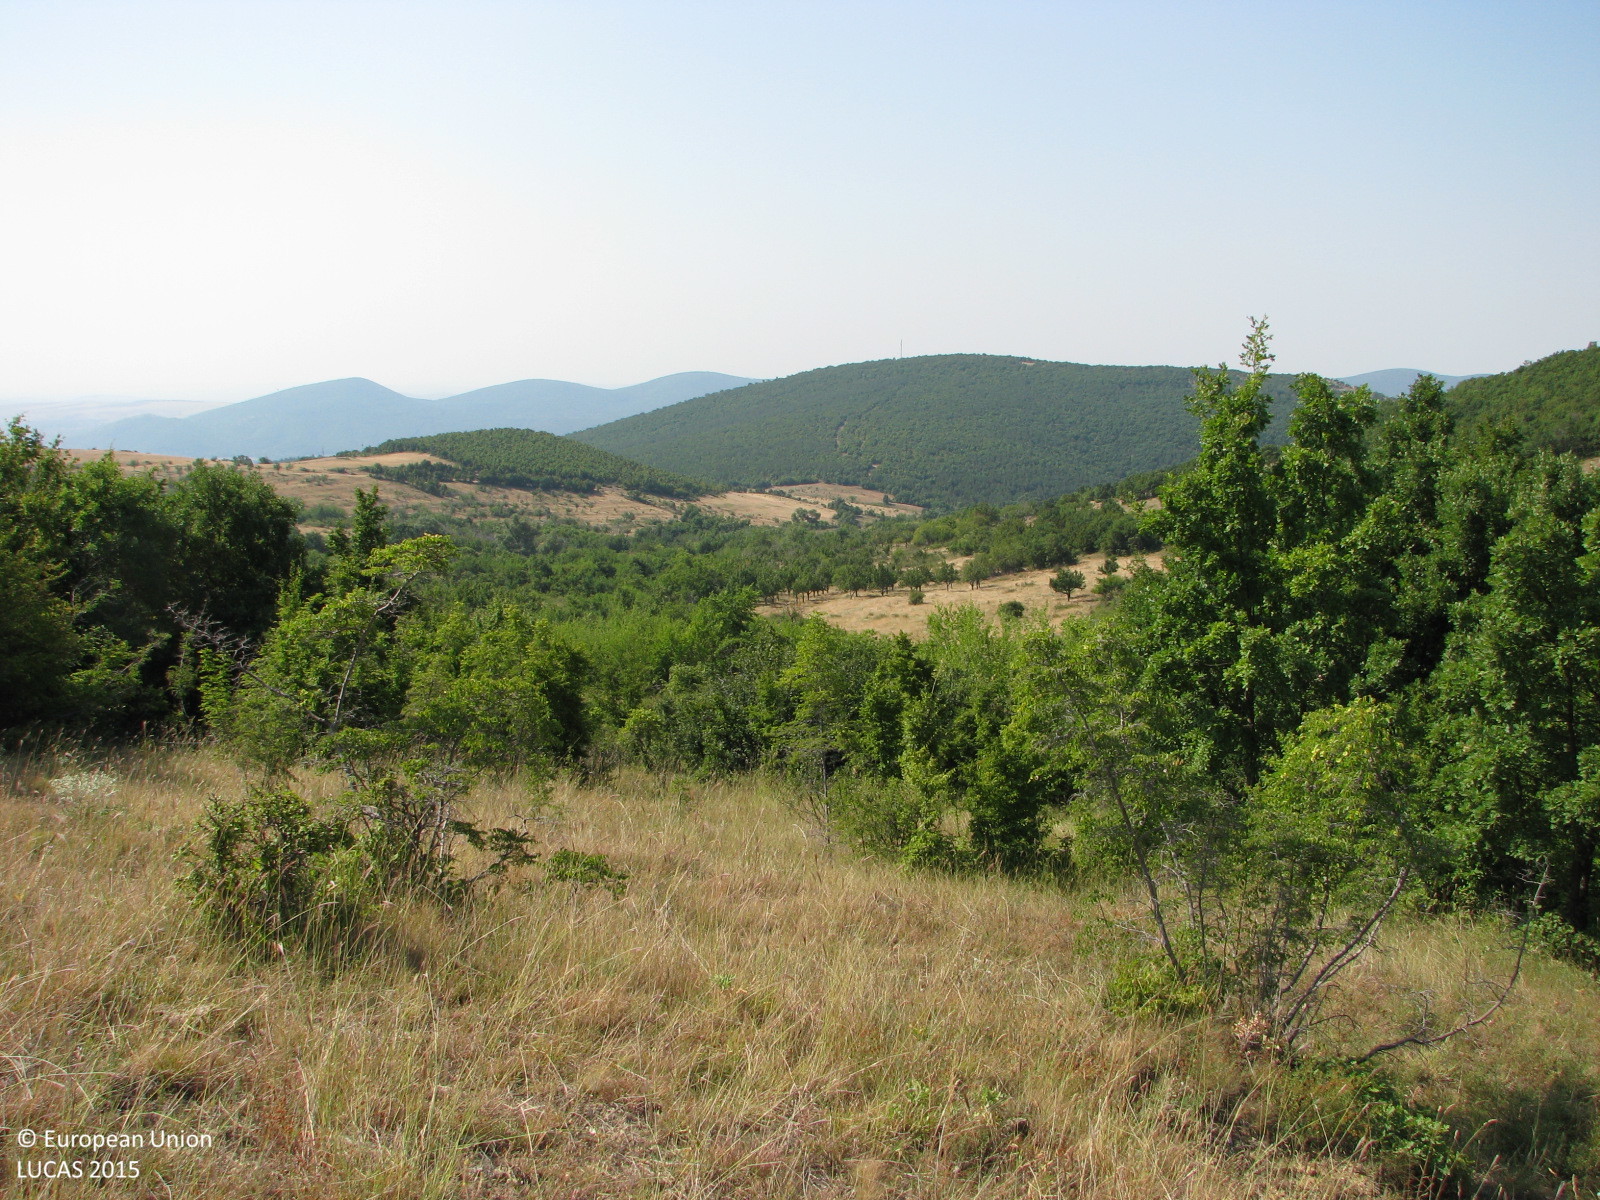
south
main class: Grassland
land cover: Grassland with sparse tree/shrub cover
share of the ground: > 75 %
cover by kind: herbaceous plants 90 %, broadleaved forest trees 5 %, shrubs 5 %
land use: Agriculture (excluding fallow land and kitchen gardens)
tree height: > 5 m
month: July
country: BG
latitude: 42.6741
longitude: 26.1321
